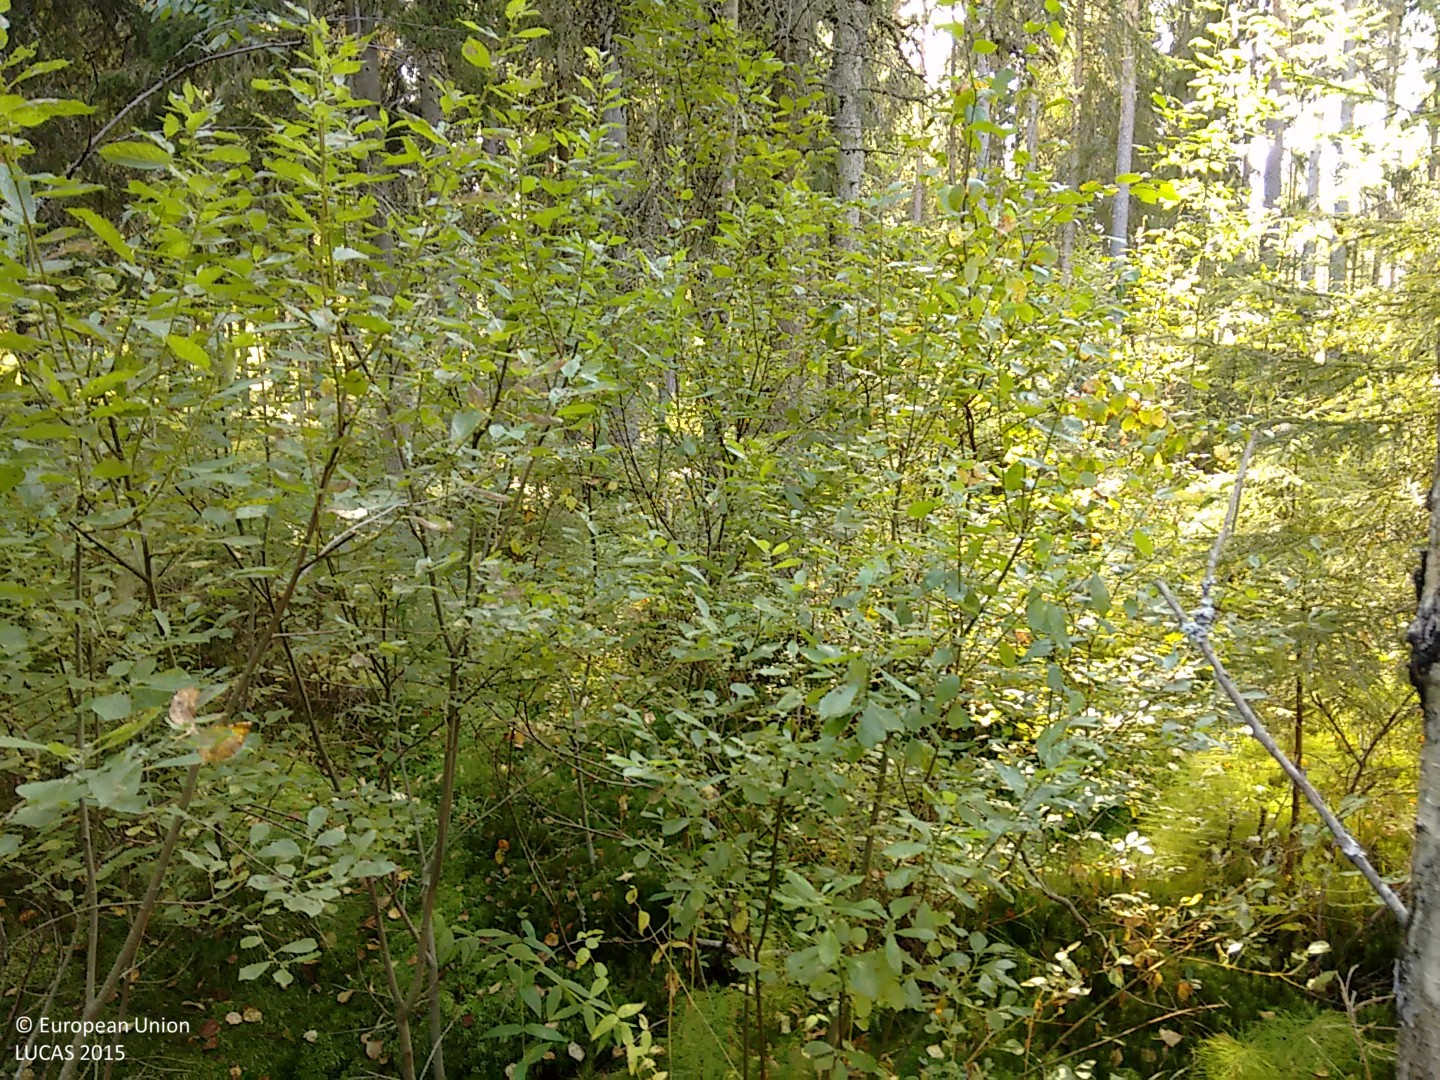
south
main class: Woodland
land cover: Spruce dominated mixed woodland
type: hemiboreal forest and nemoral coniferous forest and mixed broadleaved-coniferous forest
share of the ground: > 75 %
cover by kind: coniferous forest trees 55 %, broadleaved forest trees 30 %, shrubs 5 %, herbaceous plants 5 %, lichens and mosses 5 %
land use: Forestry
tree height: > 5 m
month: September
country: FI
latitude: 60.9760
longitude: 21.8276
